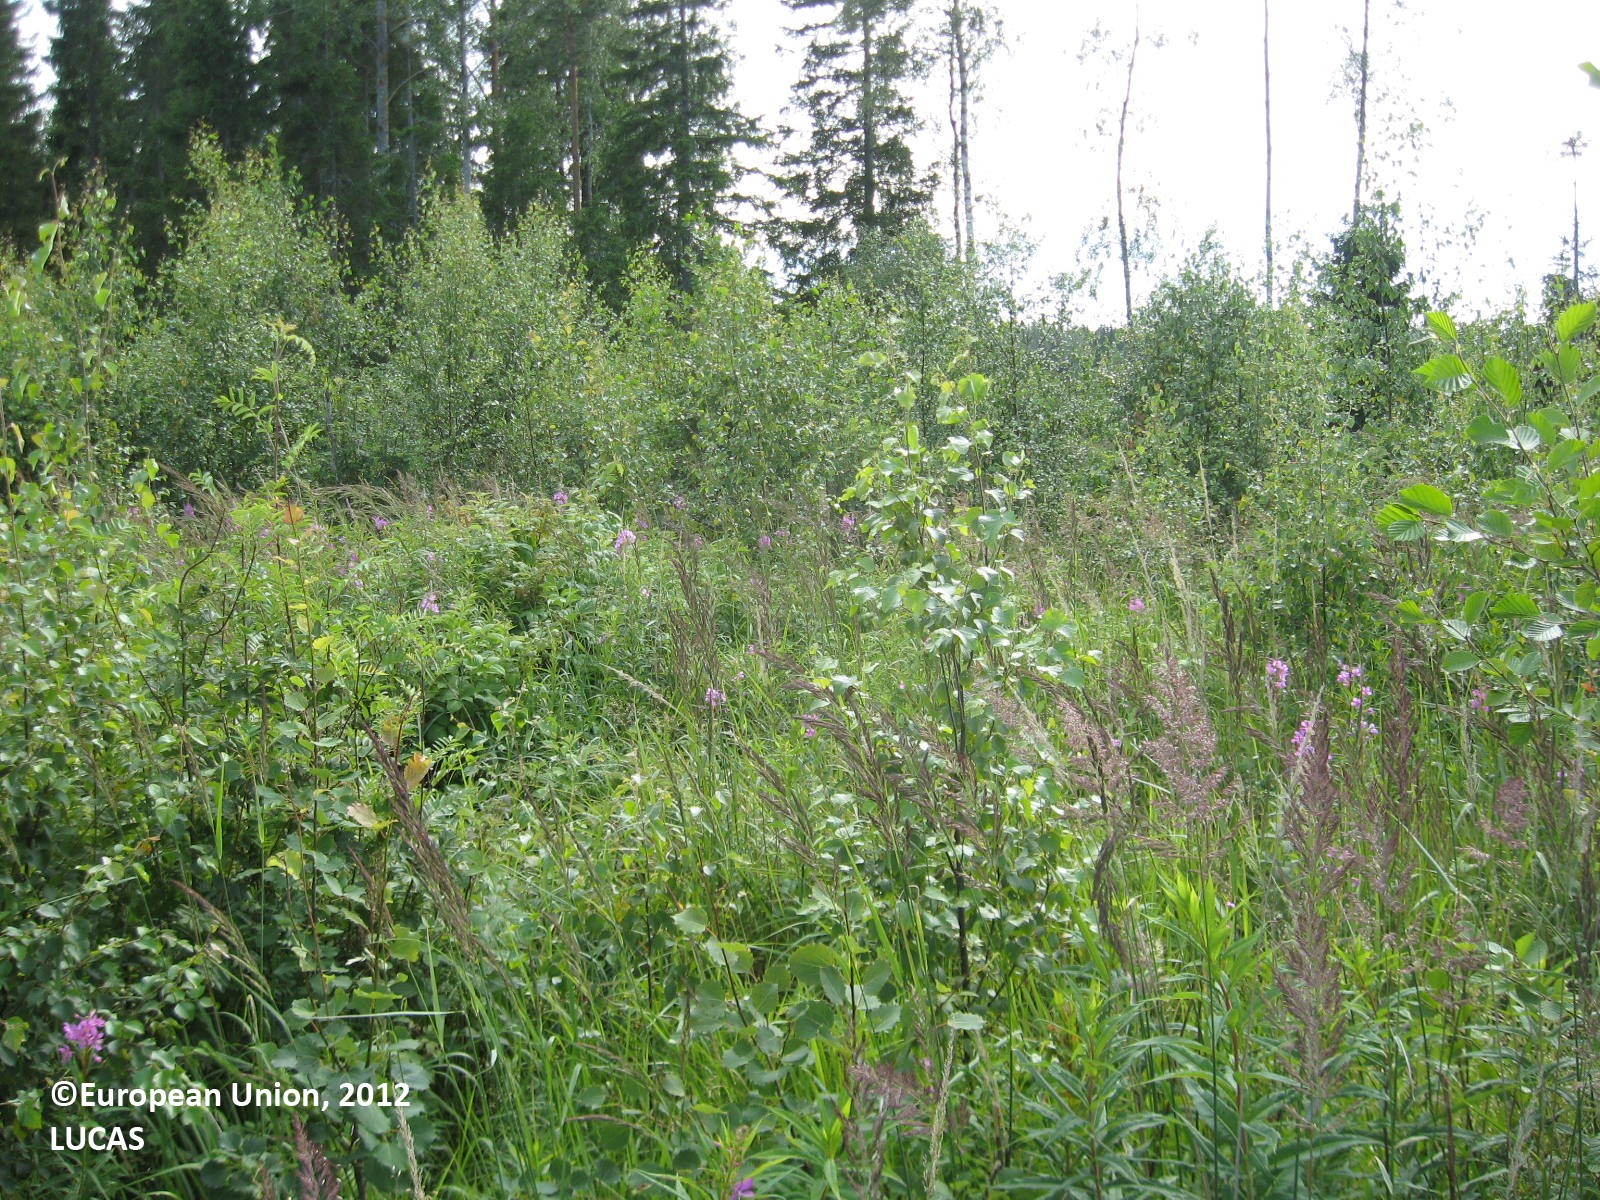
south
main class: Woodland
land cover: Other mixed woodland
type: boreal forest
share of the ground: 50 - 75 %
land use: Forestry
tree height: < 5 m
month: July
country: FI
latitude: 62.0100
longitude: 21.4491
